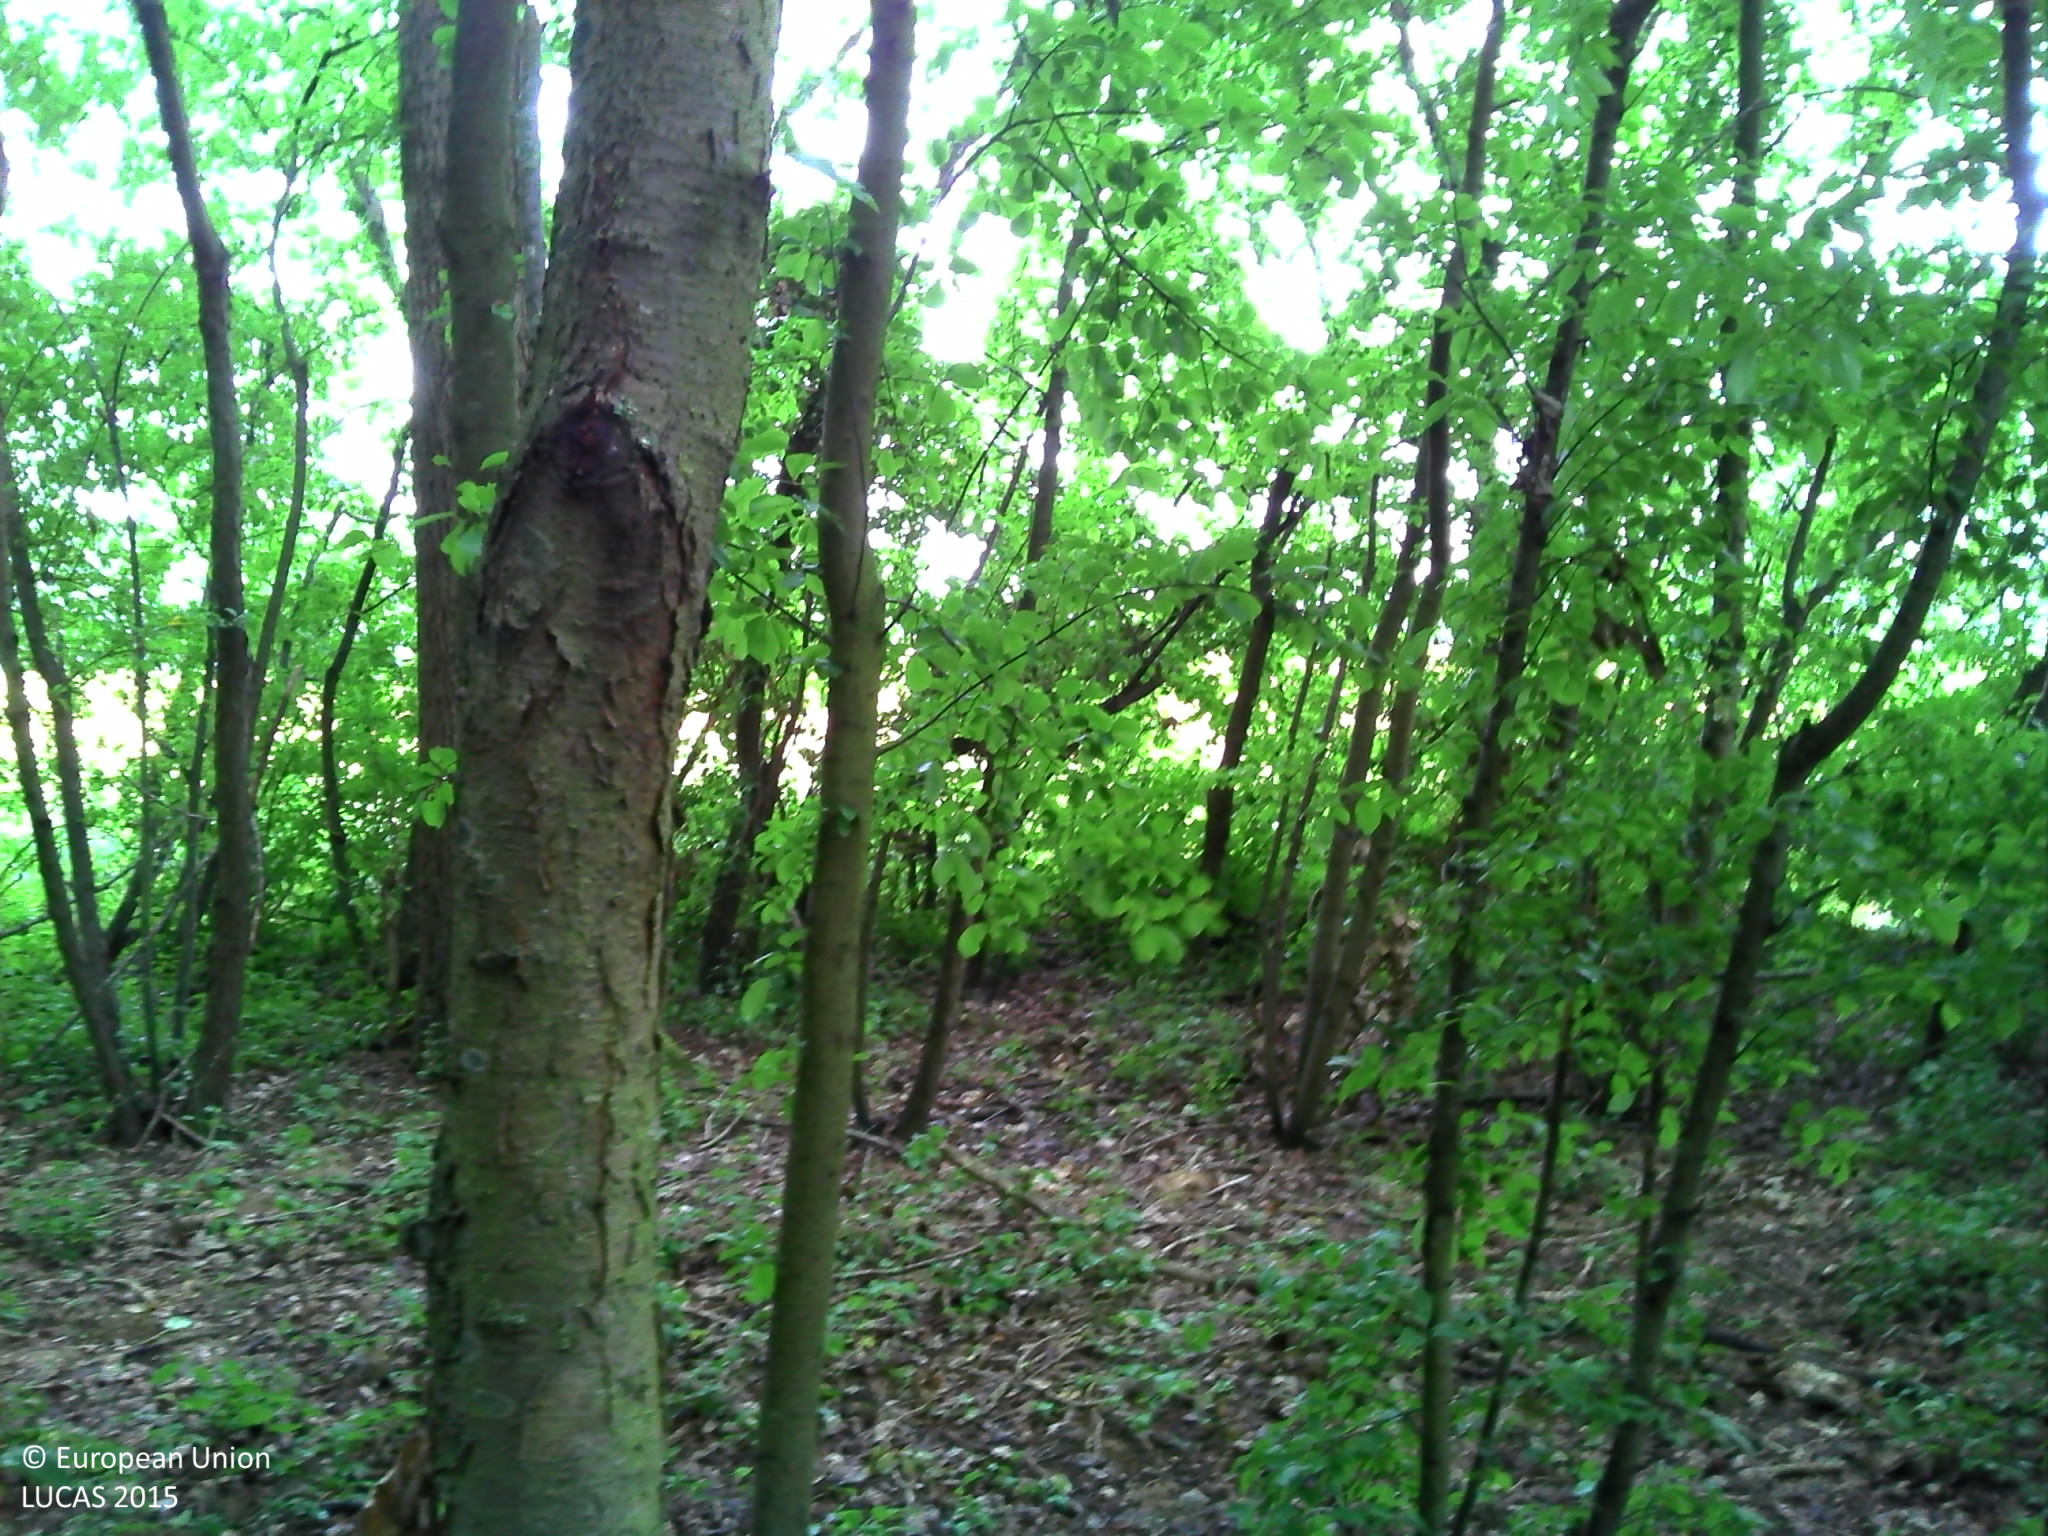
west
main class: Woodland
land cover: Broadleaved woodland
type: exotic forest
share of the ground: > 75 %
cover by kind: broadleaved forest trees 100 %
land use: Forestry
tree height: > 5 m
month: July
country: BE
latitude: 50.4236
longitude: 4.0122
